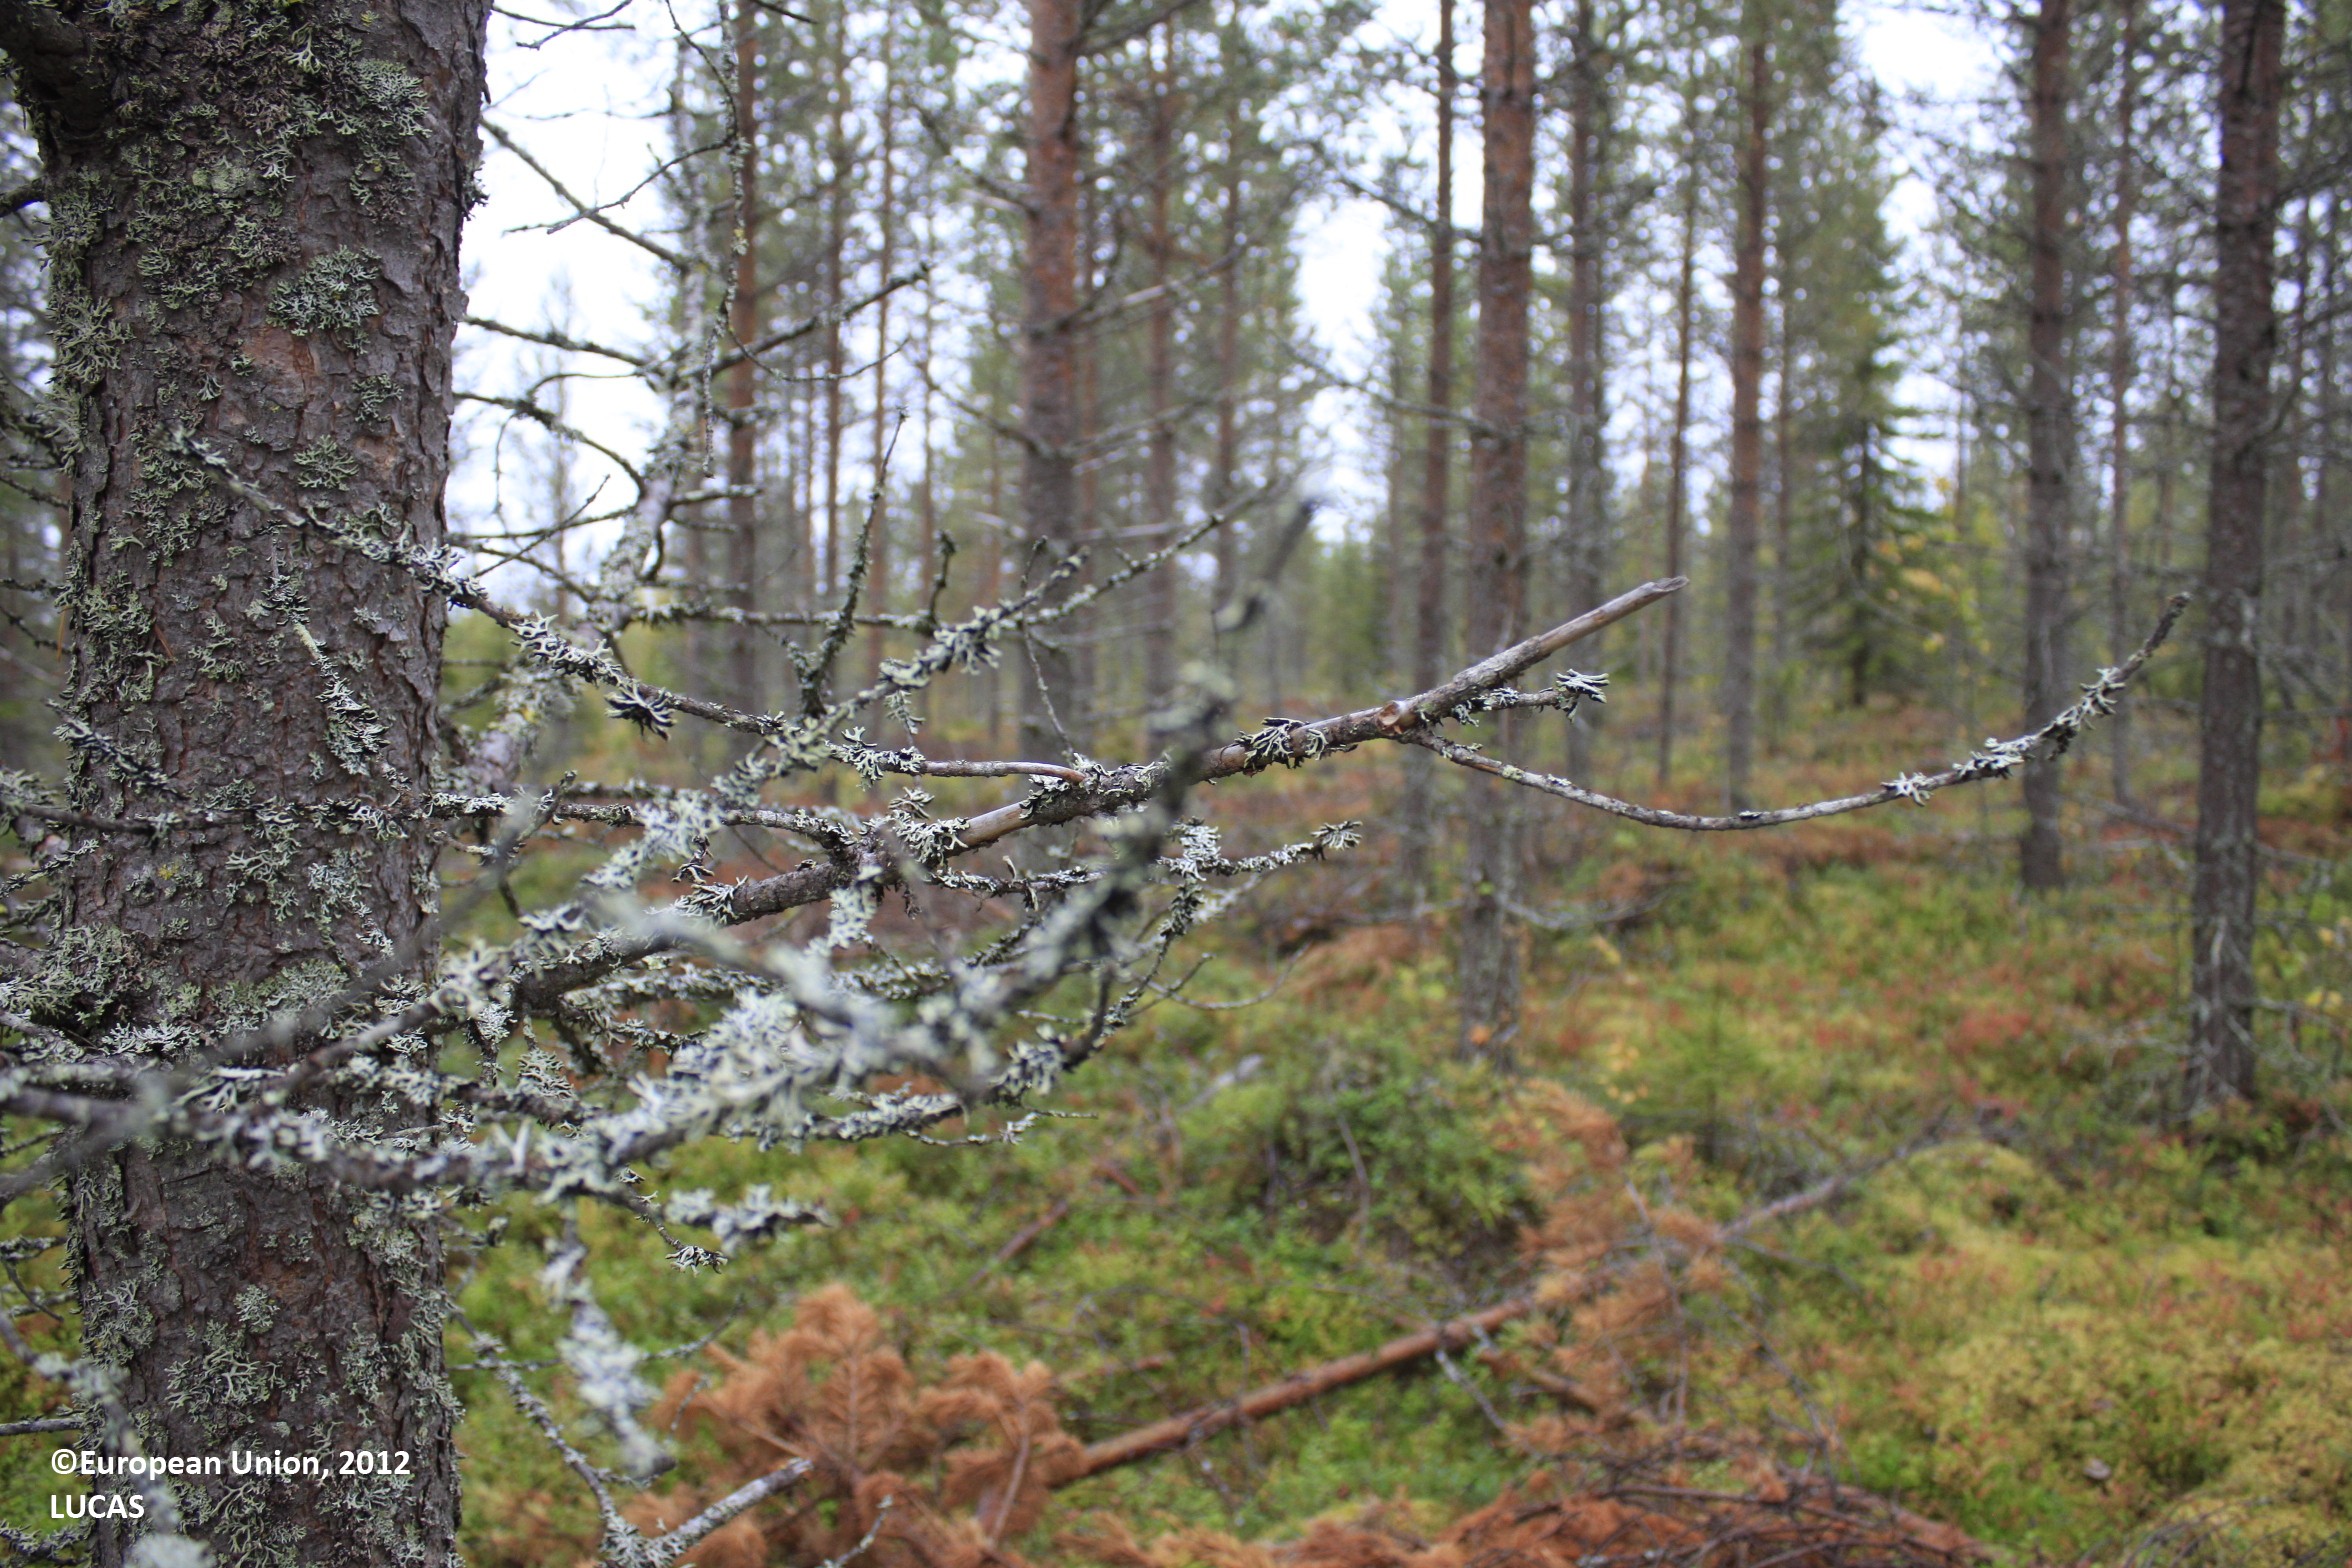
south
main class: Woodland
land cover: Pine dominated coniferous woodland
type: boreal forest
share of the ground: 25 - 50 %
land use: Forestry
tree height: > 5 m
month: September
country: FI
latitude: 65.8503
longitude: 27.1788
